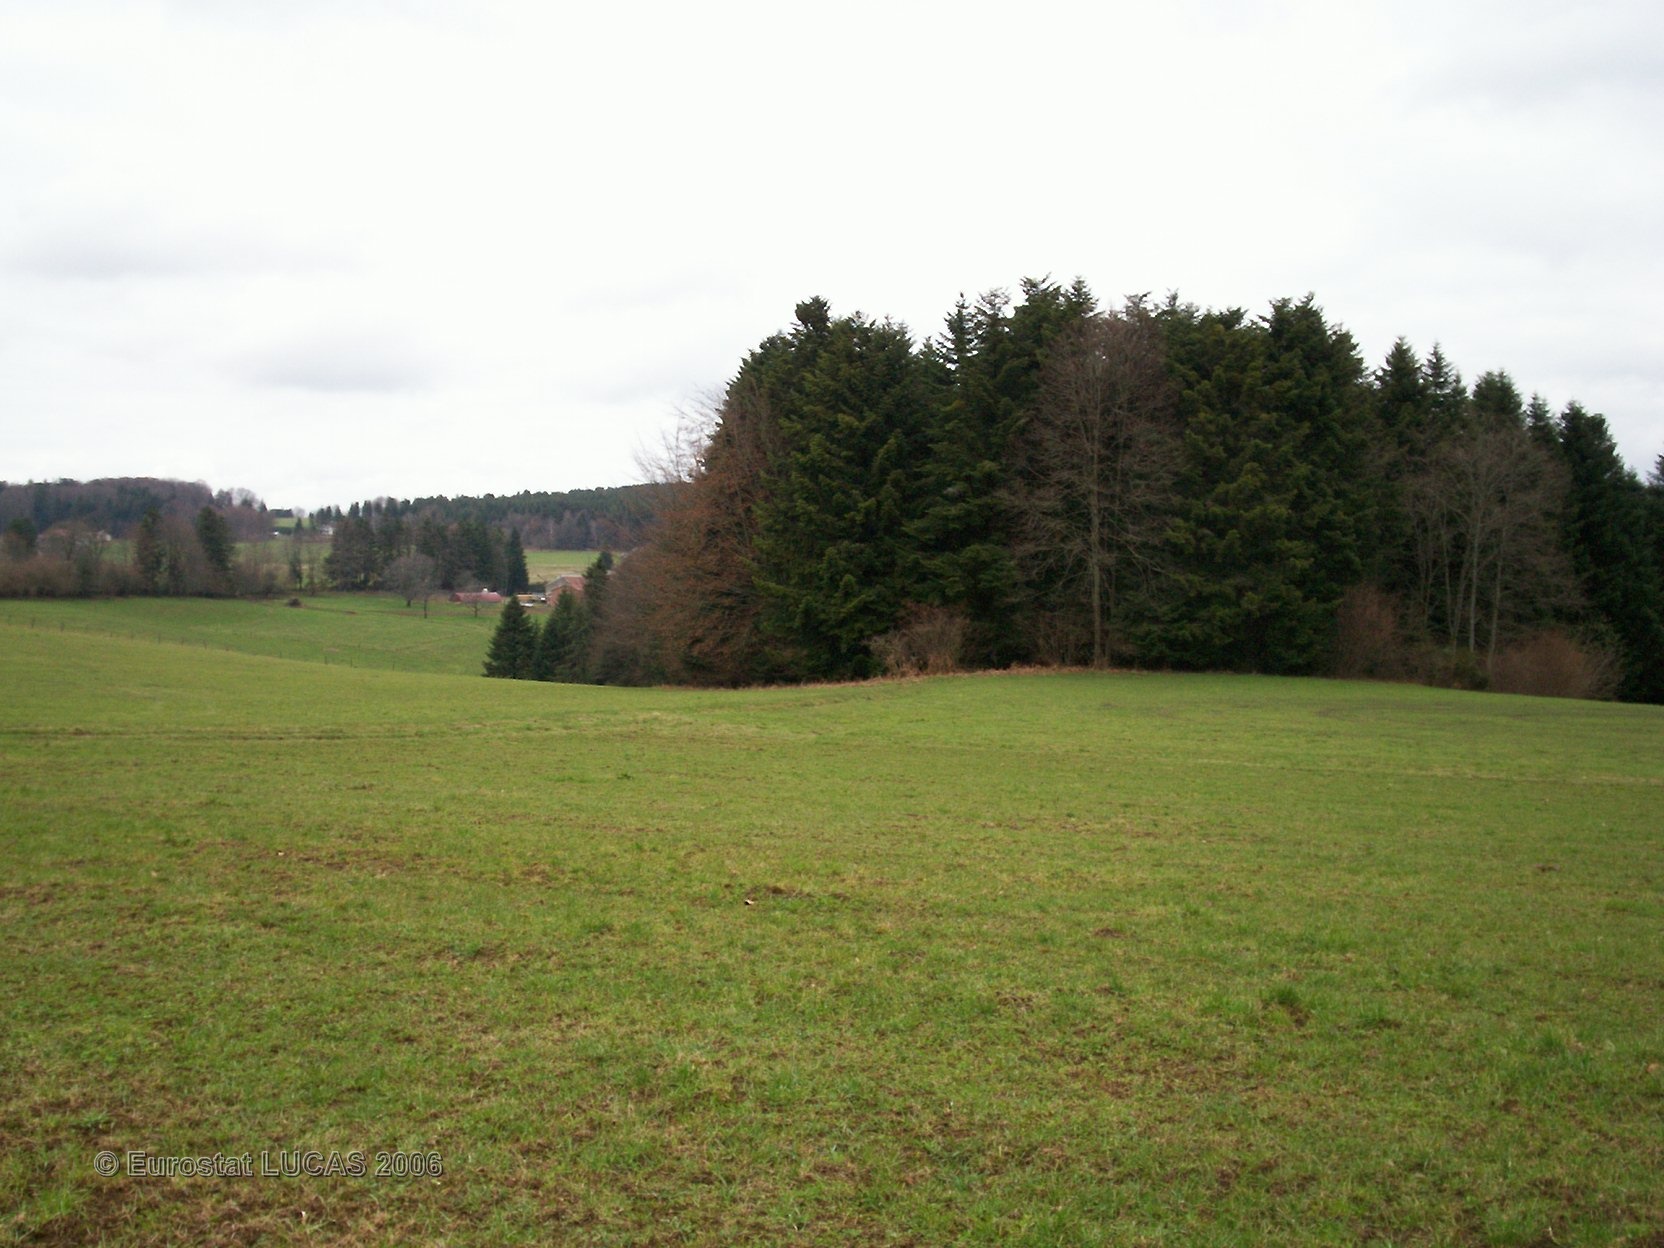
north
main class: Grassland
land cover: Grassland without tree/shrub cover
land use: Agriculture (excluding fallow land and kitchen gardens)
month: April
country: FR
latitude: 47.9521
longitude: 6.5062
